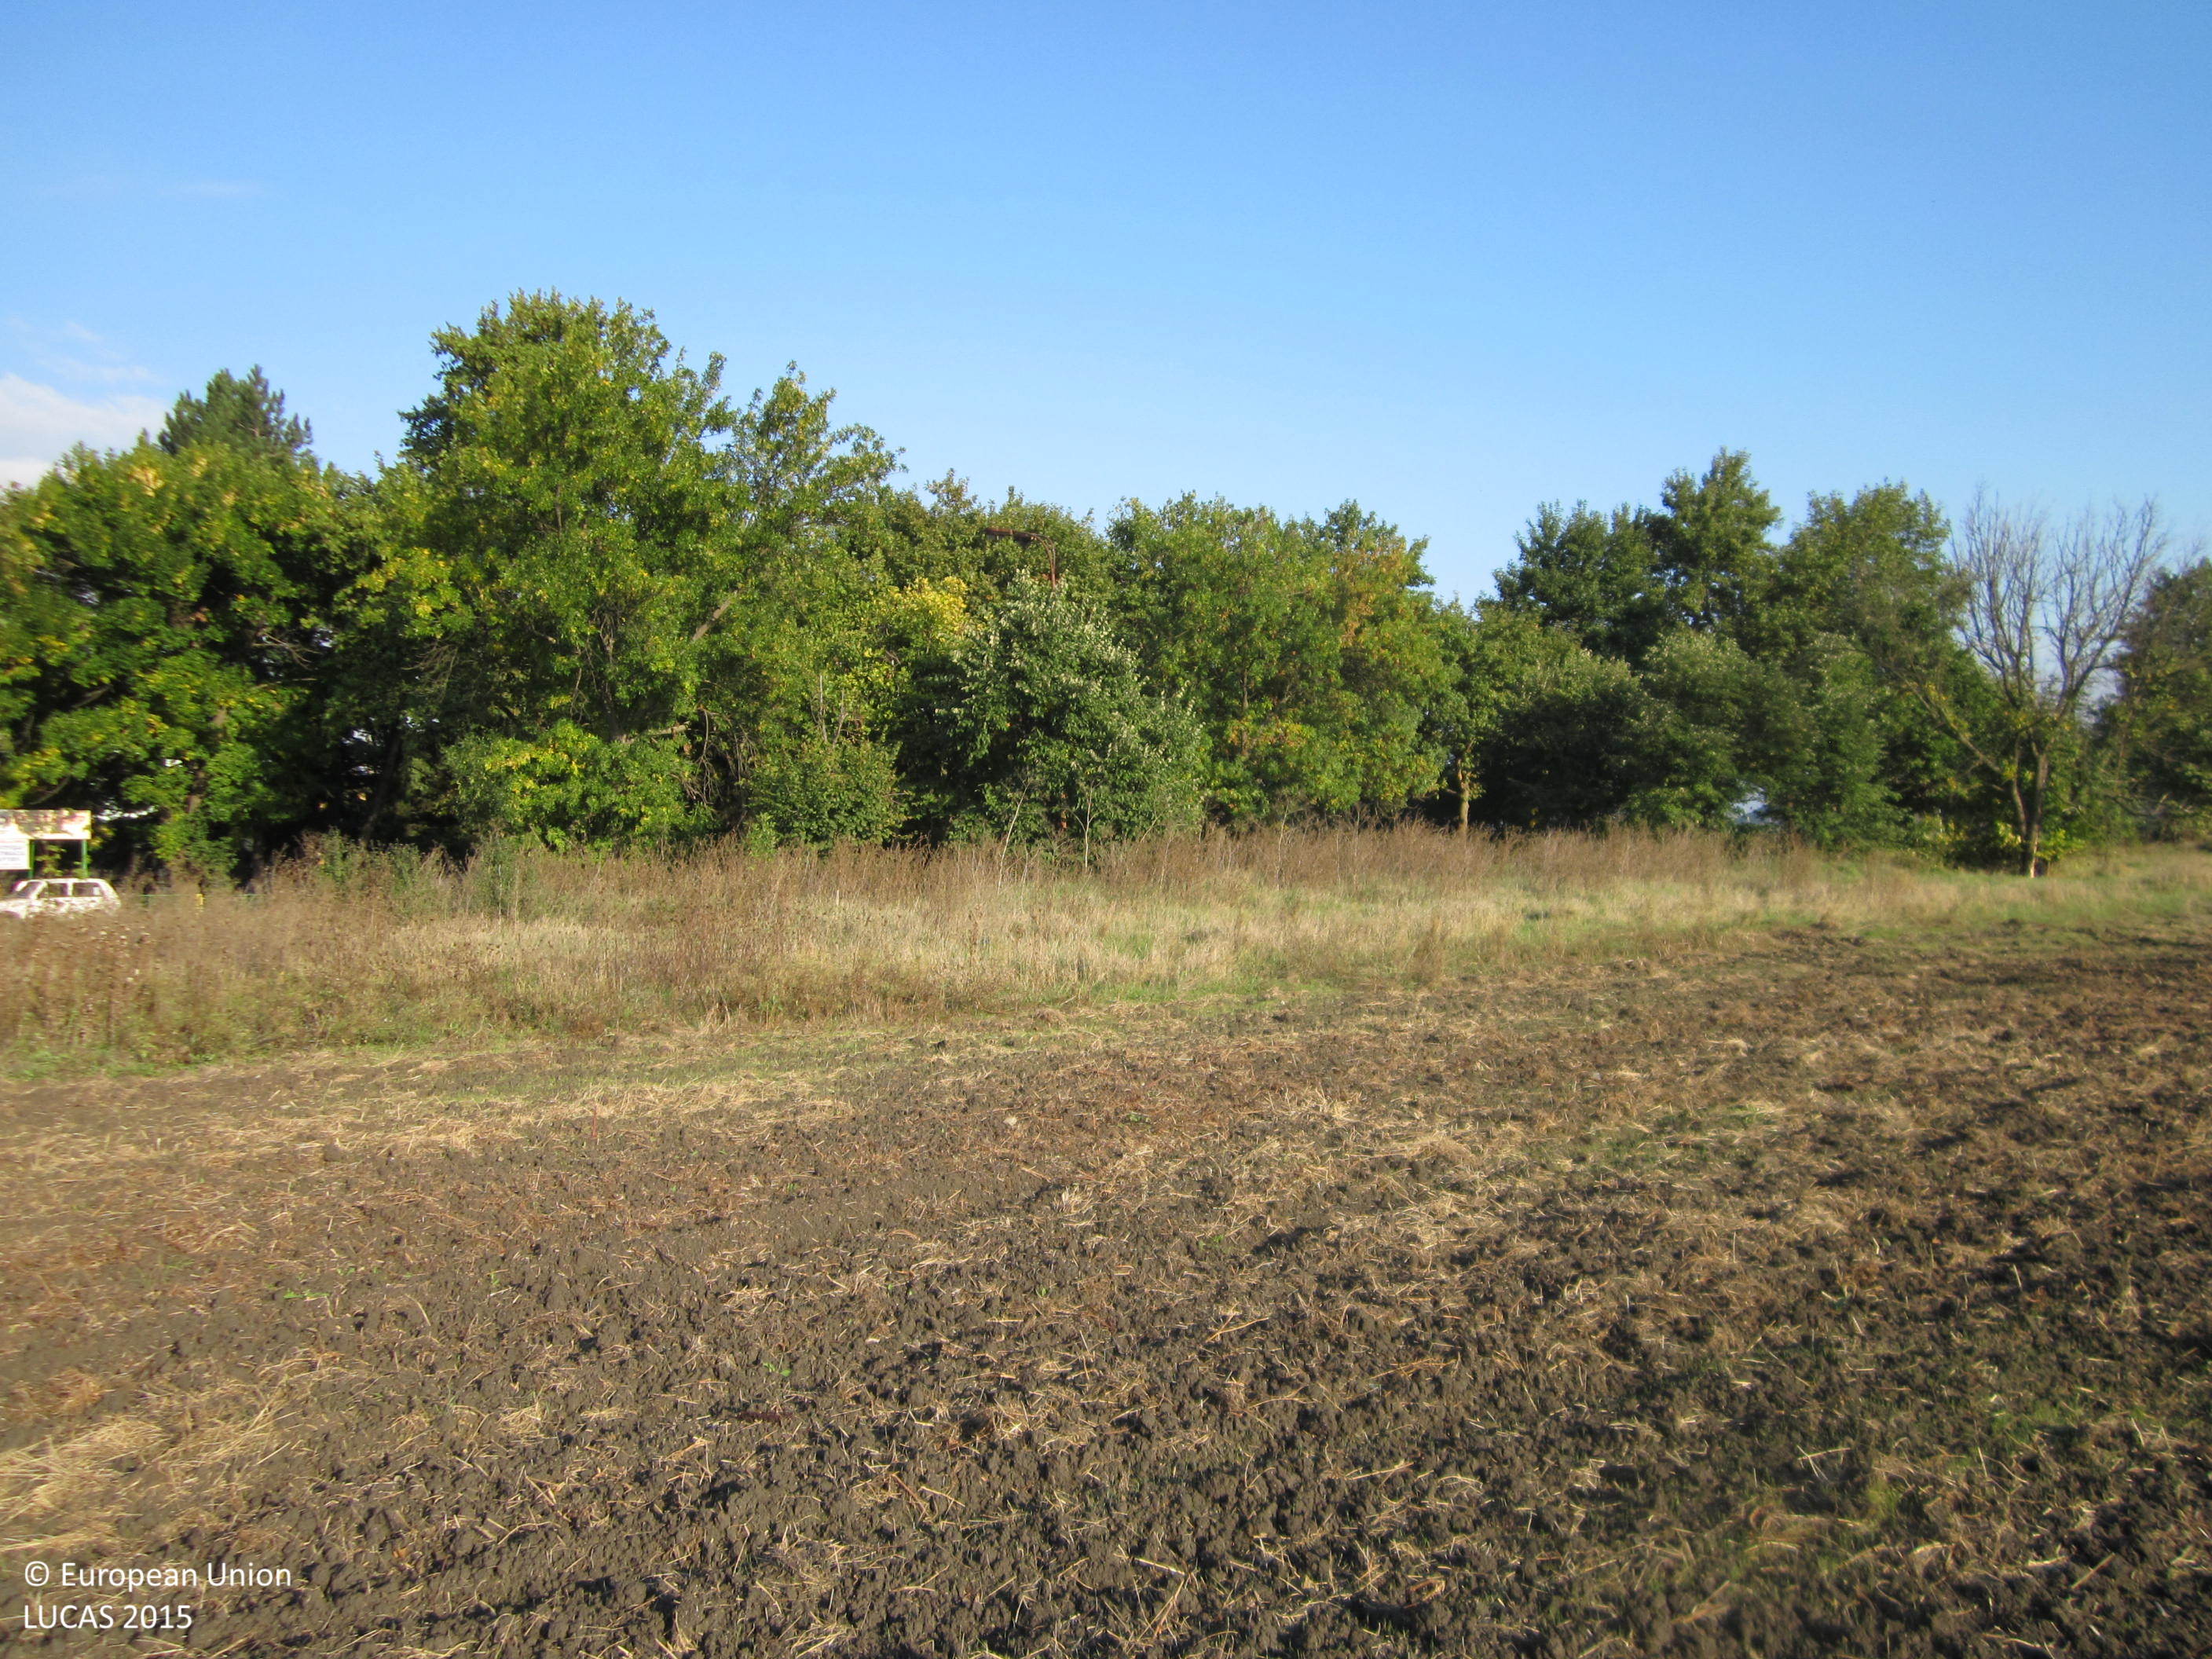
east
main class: Cropland
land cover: Common wheat
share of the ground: < 10 %
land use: Agriculture (excluding fallow land and kitchen gardens)
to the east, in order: Common wheat; Grass margins; Lines of trees; Artificial constructions in urban areas; Lines of trees
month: October
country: BG
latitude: 42.6627
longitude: 26.9791
